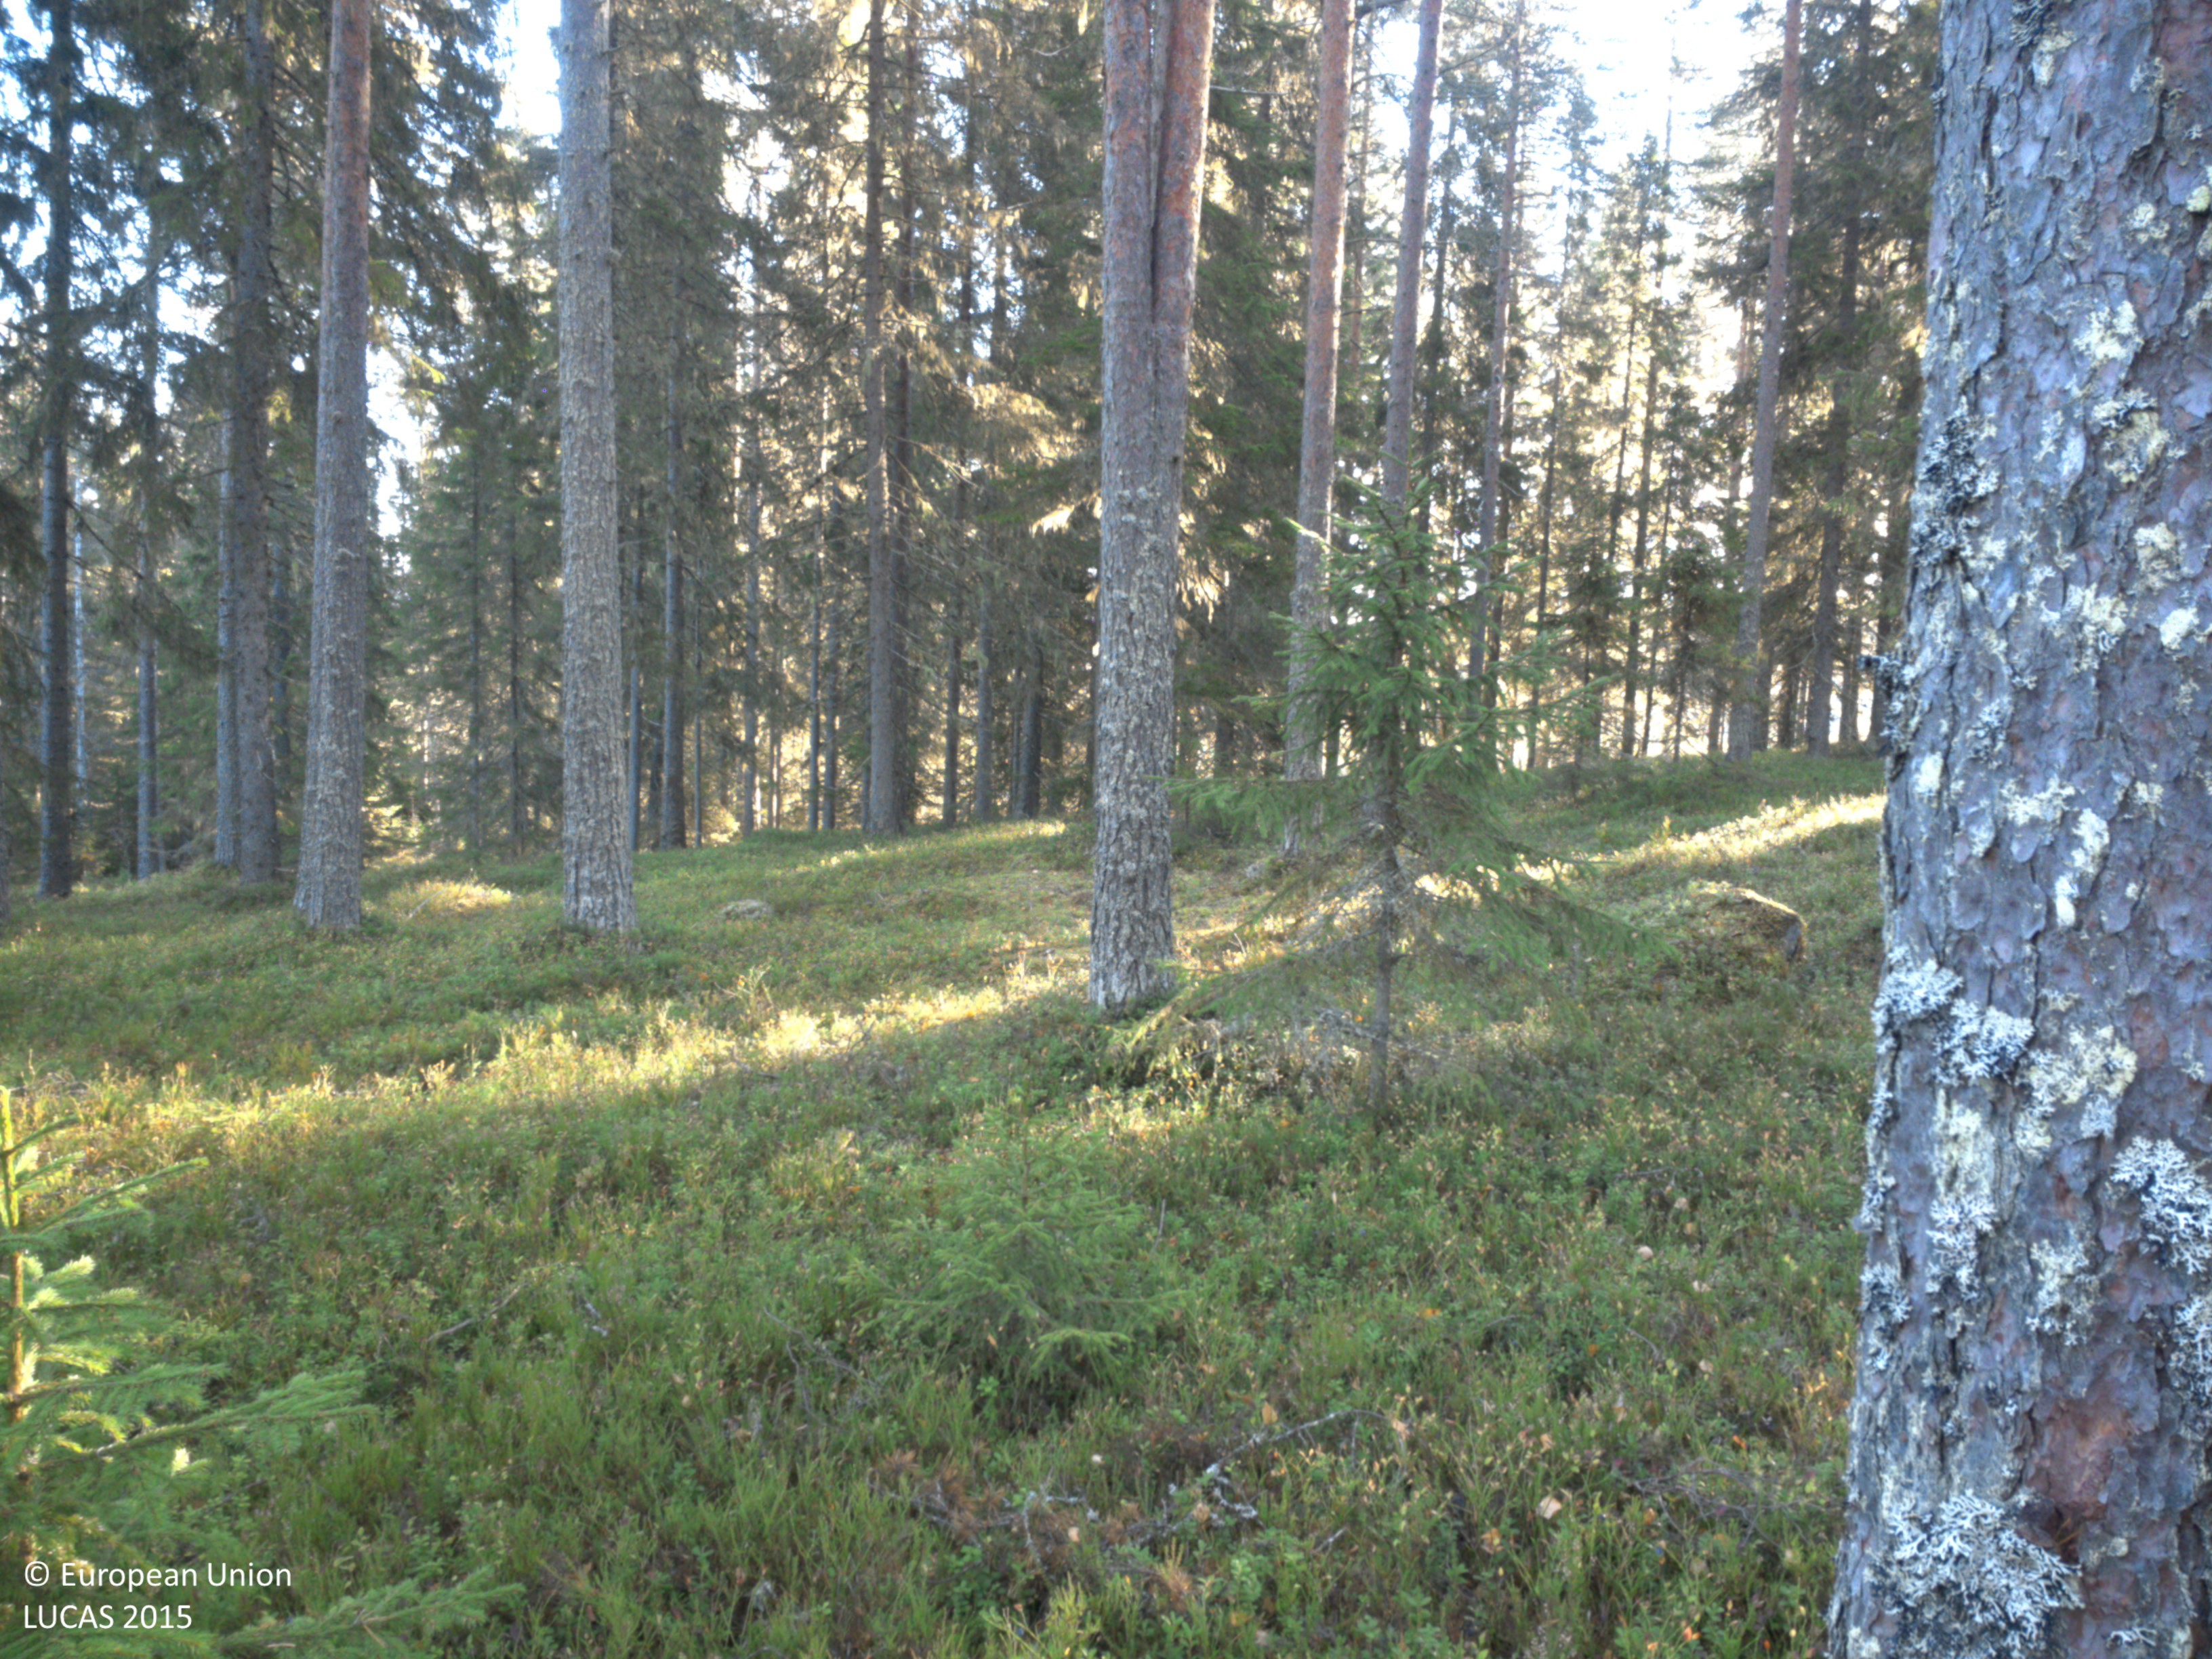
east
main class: Woodland
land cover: Pine dominated coniferous woodland
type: boreal forest
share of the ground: > 75 %
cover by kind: coniferous forest trees 85 %, shrubs 5 %, herbaceous plants 5 %, lichens and mosses 5 %
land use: Forestry
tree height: > 5 m
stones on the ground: < 10 %
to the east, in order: Pine dominated coniferous woodland; Spruce dominated coniferous woodland; Grassland with sparse tree/shrub cover; Broadleaved woodland; Grassland without tree/shrub cover; Ditches and canals; Tracks; Grassland without tree/shrub cover; Spontaneously vegetated surfaces
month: October
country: SE
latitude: 63.9313
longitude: 19.7884
